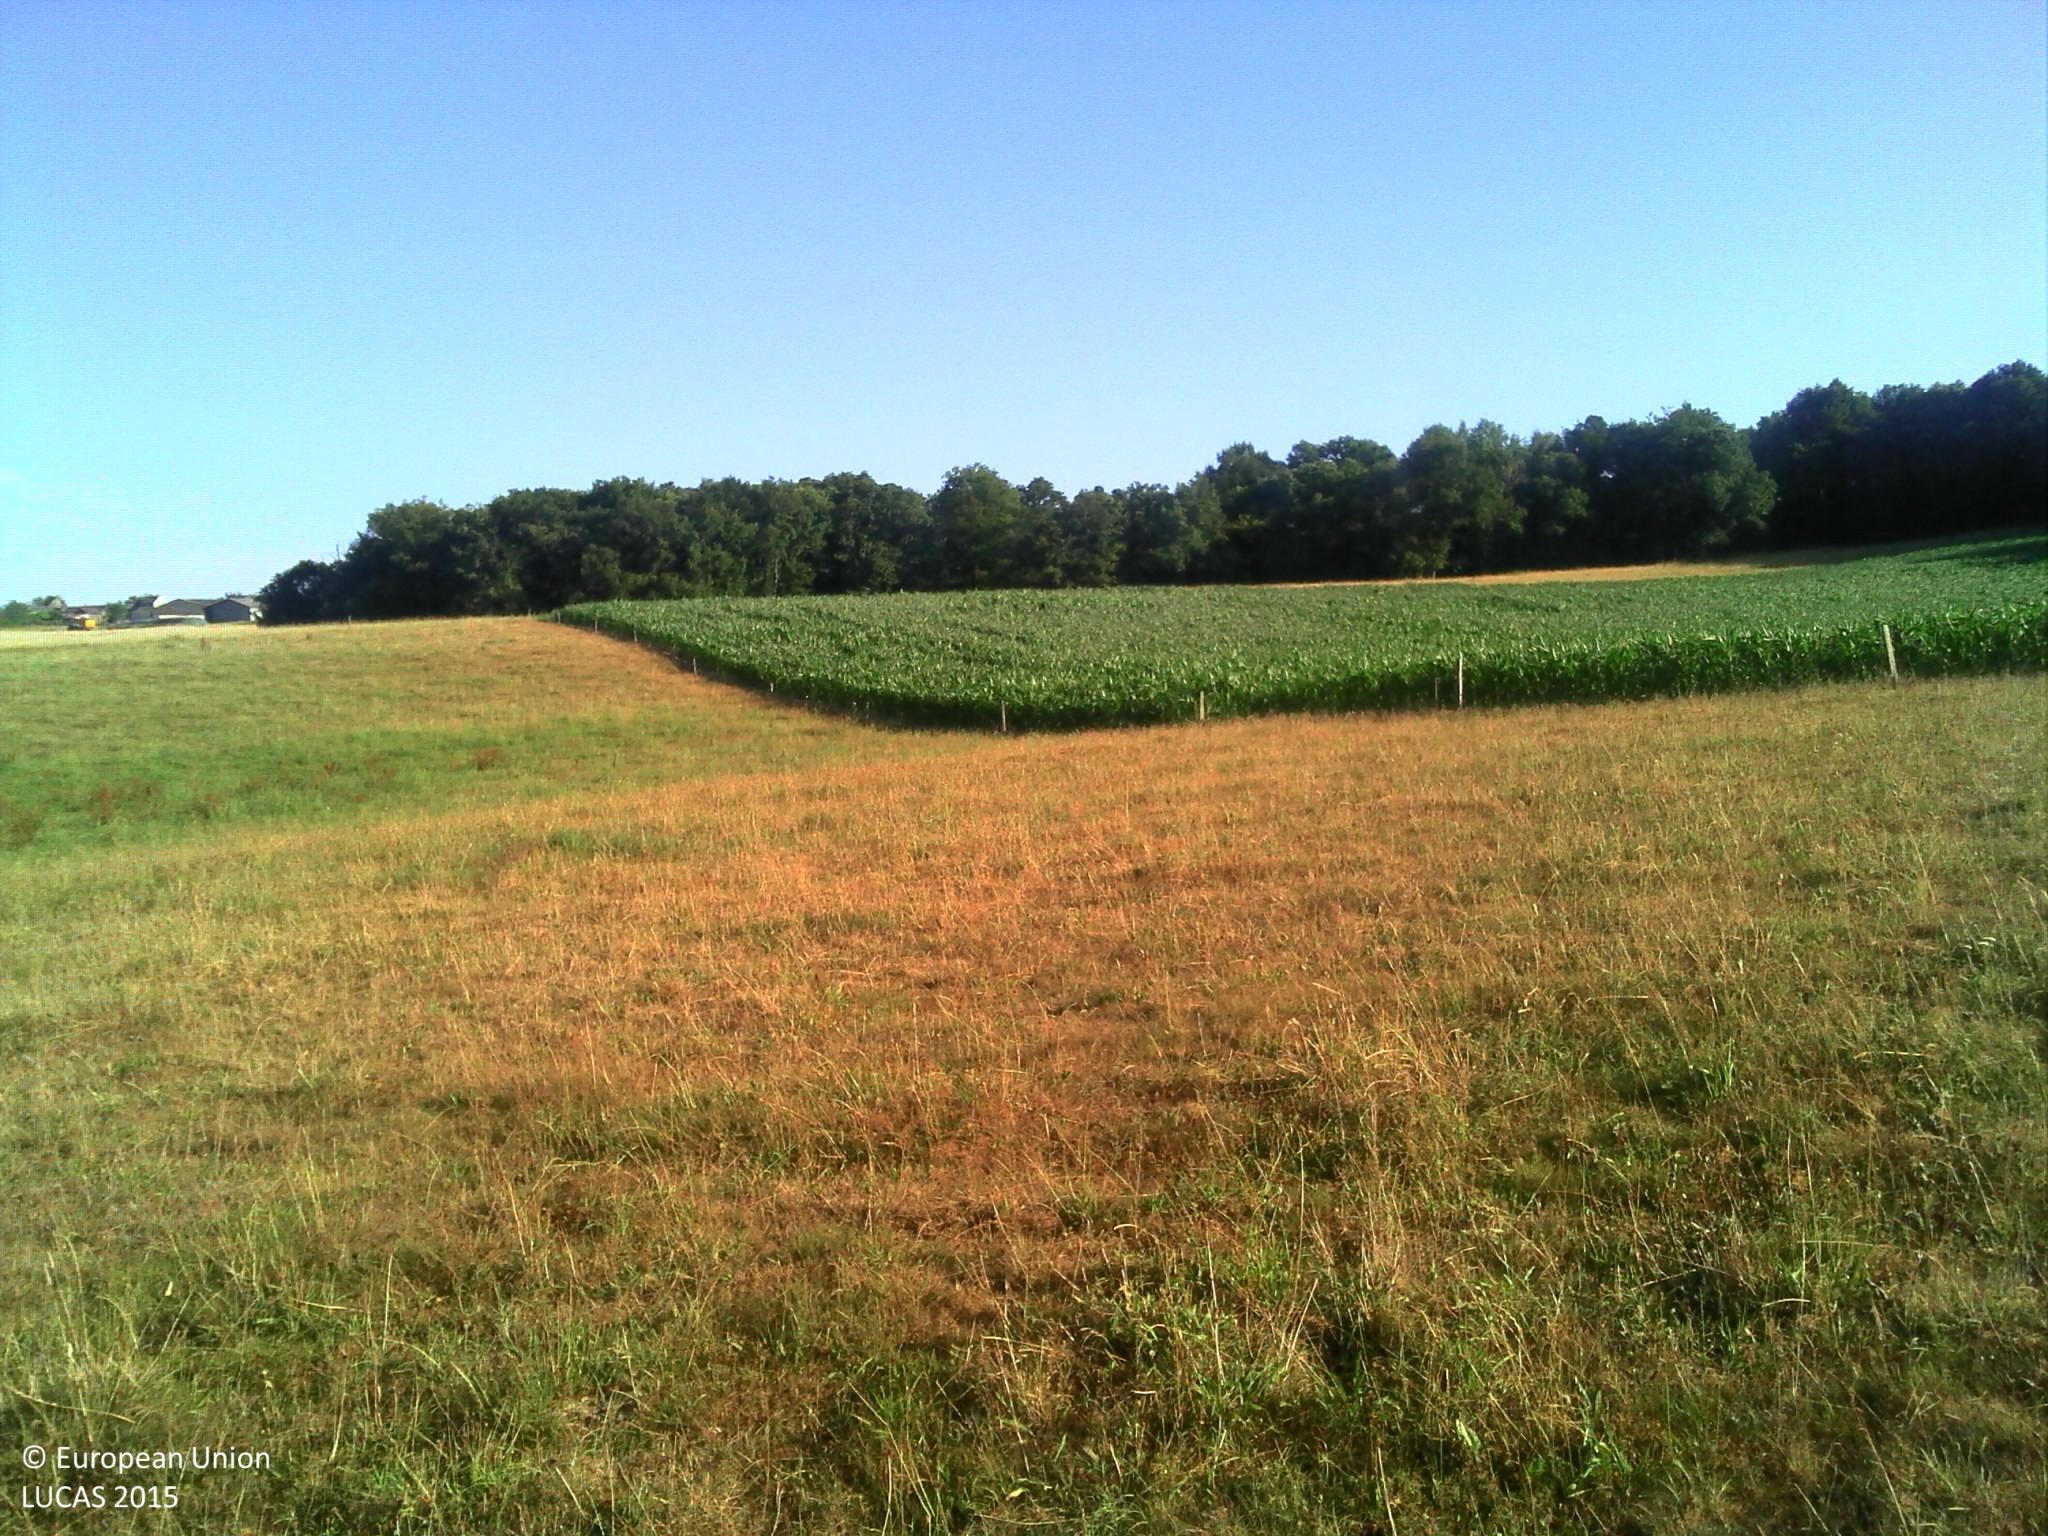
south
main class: Grassland
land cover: Grassland without tree/shrub cover
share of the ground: > 75 %
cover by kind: herbaceous plants 100 %
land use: Agriculture (excluding fallow land and kitchen gardens)
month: July
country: FR
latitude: 46.2397
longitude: 1.6267
